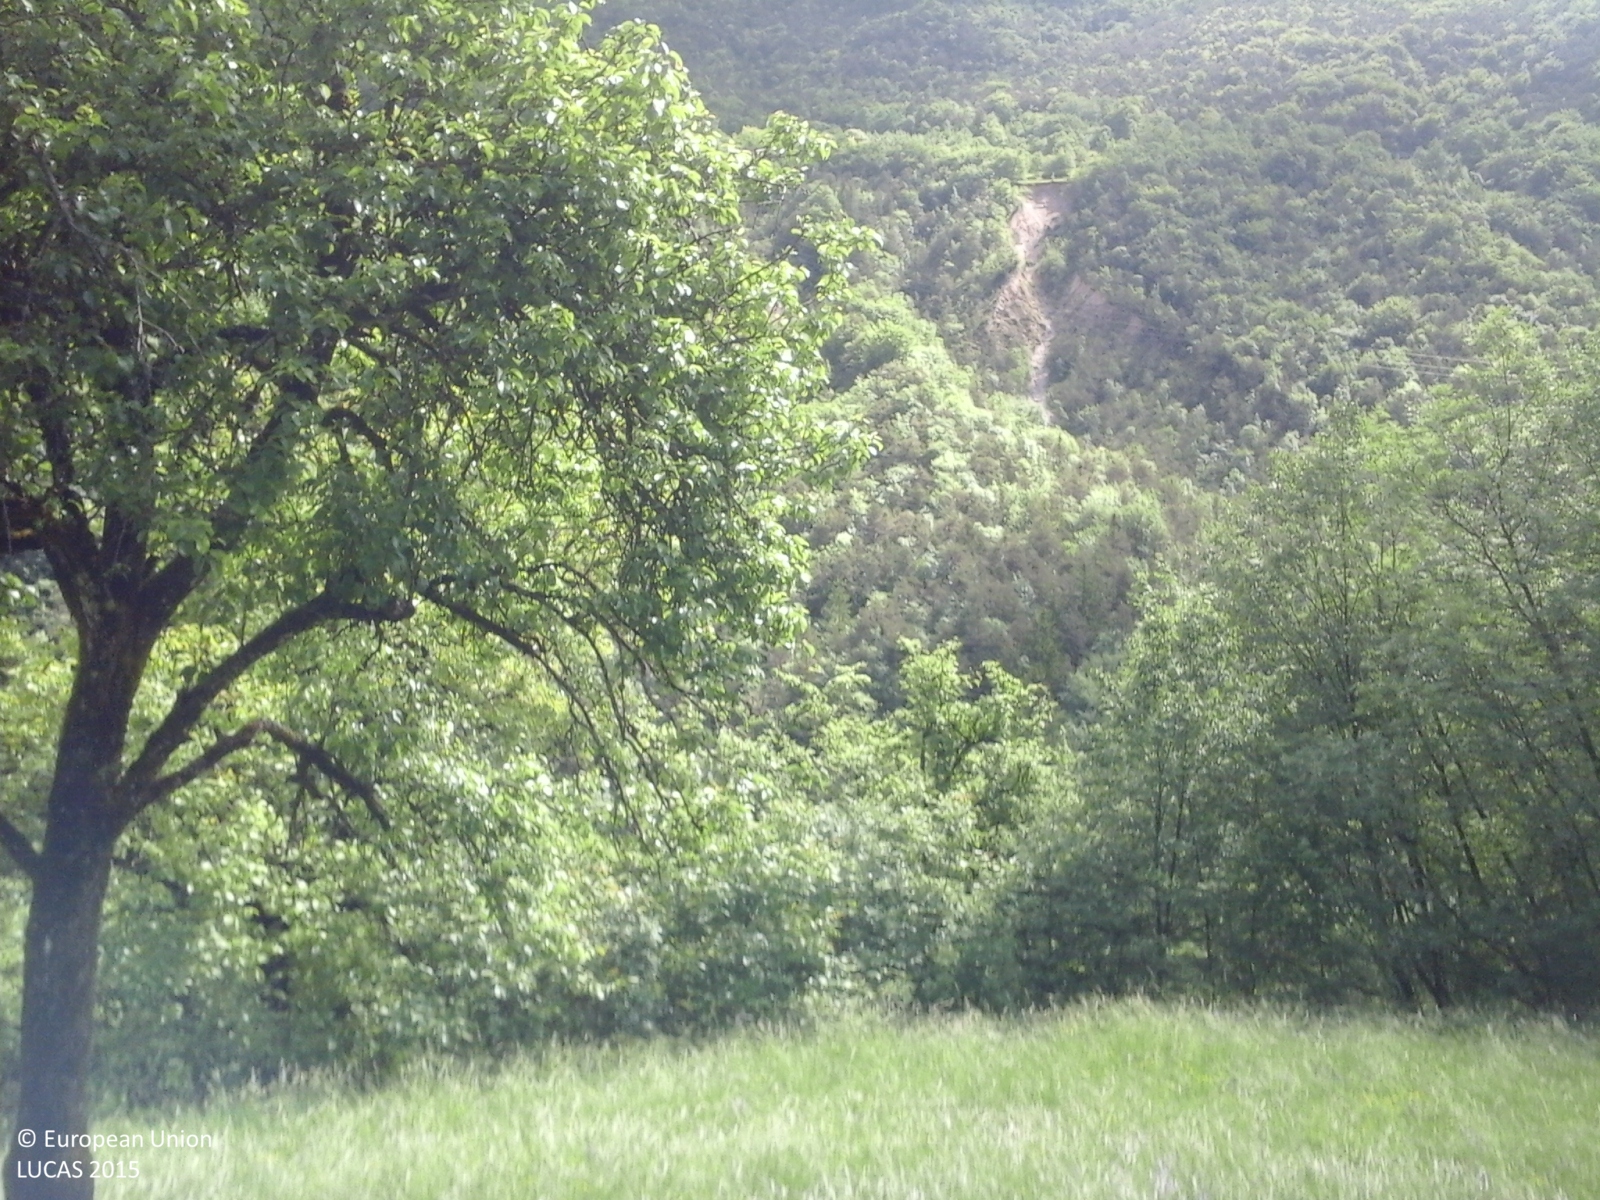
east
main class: Grassland
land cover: Grassland with sparse tree/shrub cover
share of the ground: > 75 %
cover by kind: herbaceous plants 95 %, broadleaved forest trees 5 %
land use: Semi-natural and natural areas not in use
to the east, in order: Grassland with sparse tree/shrub cover; Broadleaved woodland; Inland fresh running water; Broadleaved woodland; Other mixed woodland
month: May
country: IT
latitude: 45.8051
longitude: 11.0920
